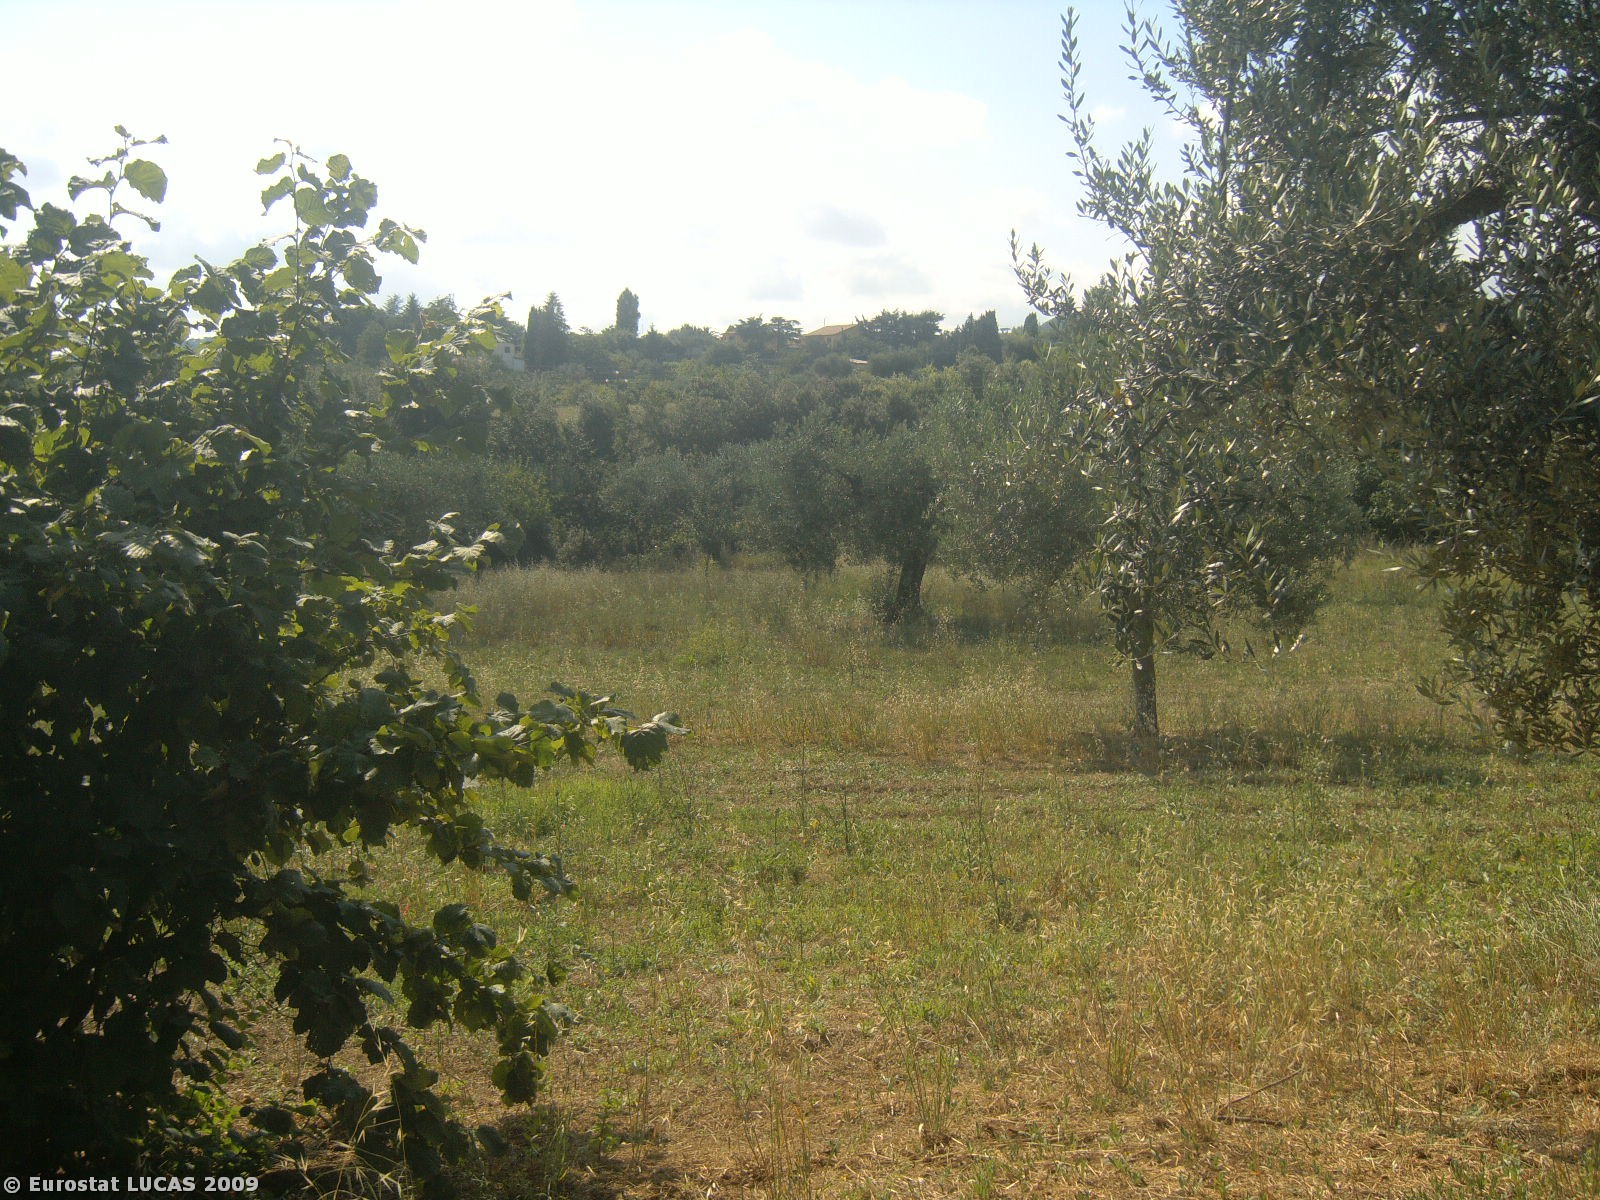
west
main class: Cropland
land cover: Nuts trees
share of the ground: 25 - 50 %
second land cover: Olive groves
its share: 25 - 50 %
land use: Agriculture (excluding fallow land and kitchen gardens)
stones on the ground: < 10 %
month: June
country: IT
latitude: 41.6769
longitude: 12.7402
